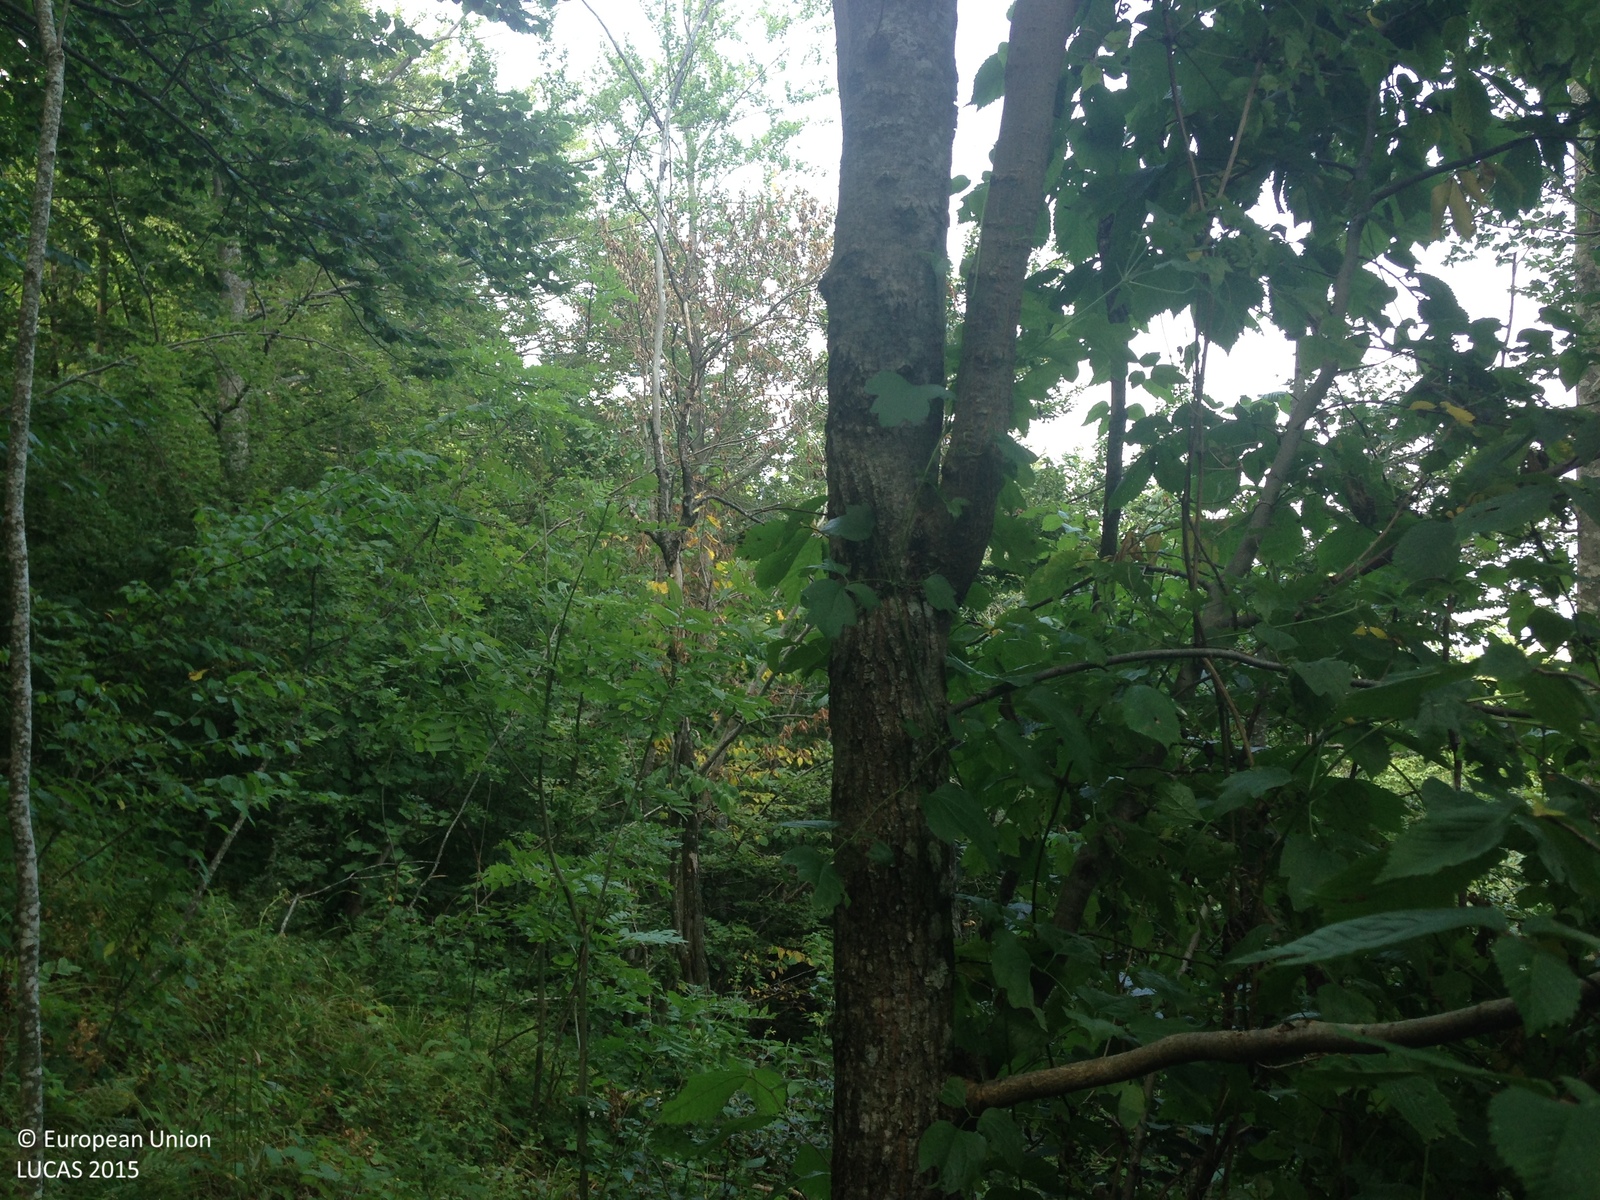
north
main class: Woodland
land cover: Broadleaved woodland
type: thermophilous deciduous forest
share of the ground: > 75 %
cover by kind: broadleaved forest trees 55 %, shrubs 10 %, herbaceous plants 10 %, lichens and mosses 10 %, unconsolidated bare surface 10 %, consolidated bare surface 5 %
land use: Forestry
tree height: > 5 m
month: July
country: HR
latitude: 44.8578
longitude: 15.0939
